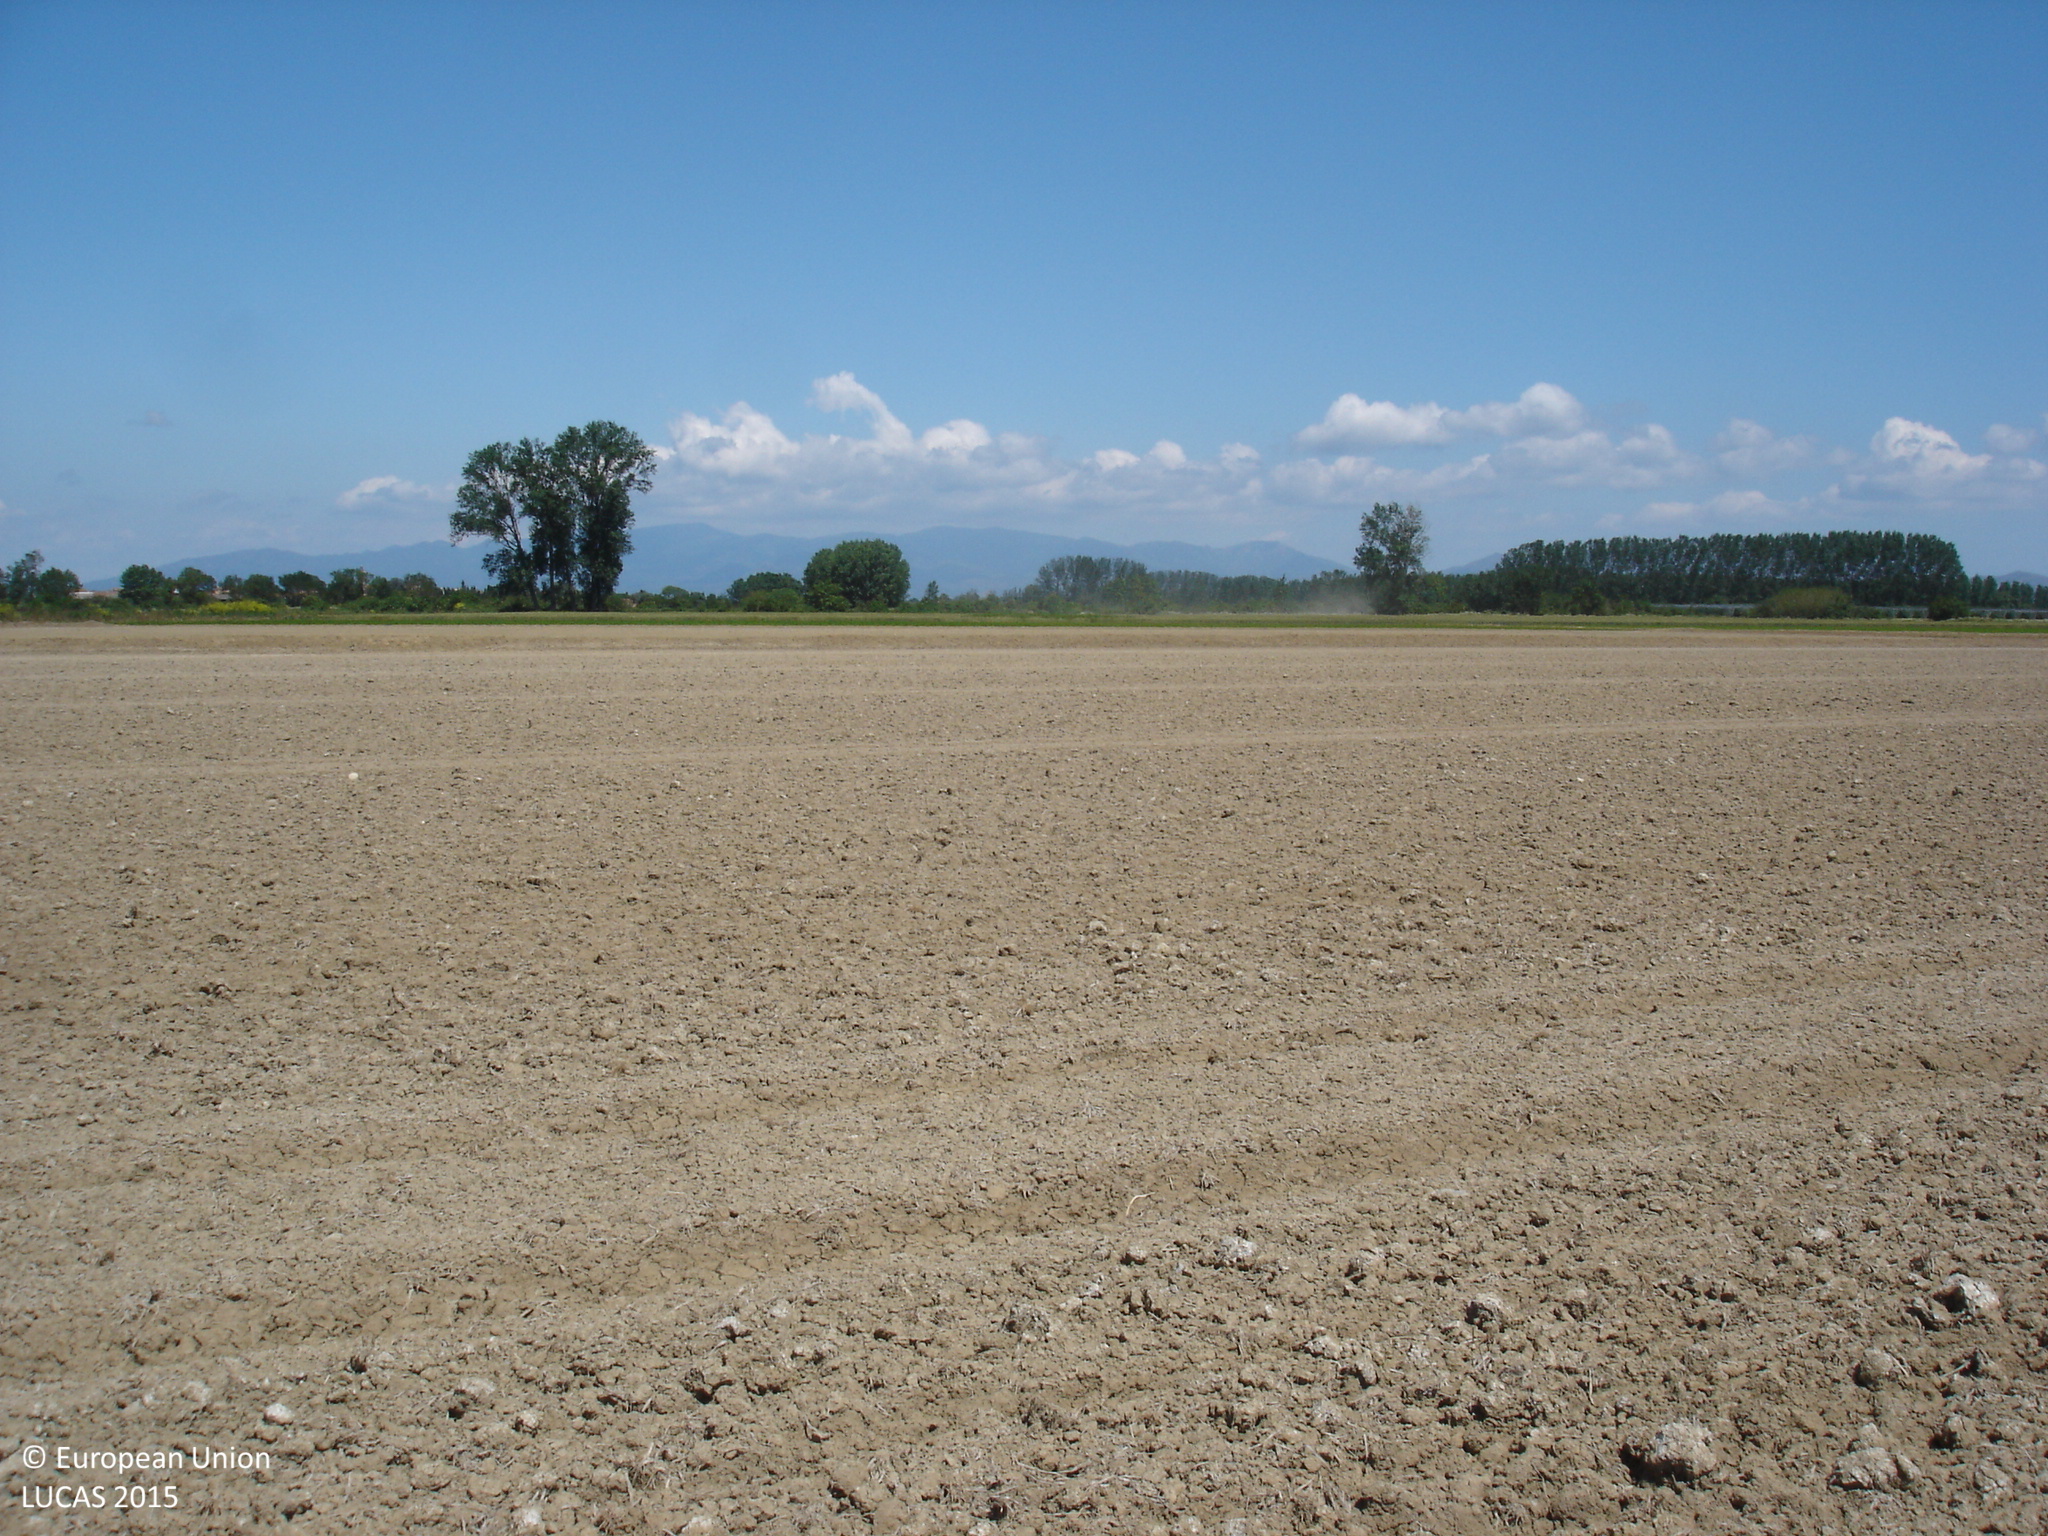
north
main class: Cropland
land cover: Rice
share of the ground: < 10 %
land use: Agriculture (excluding fallow land and kitchen gardens)
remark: Tilled/Sowed
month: May
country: ES
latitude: 42.2157
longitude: 3.0492
